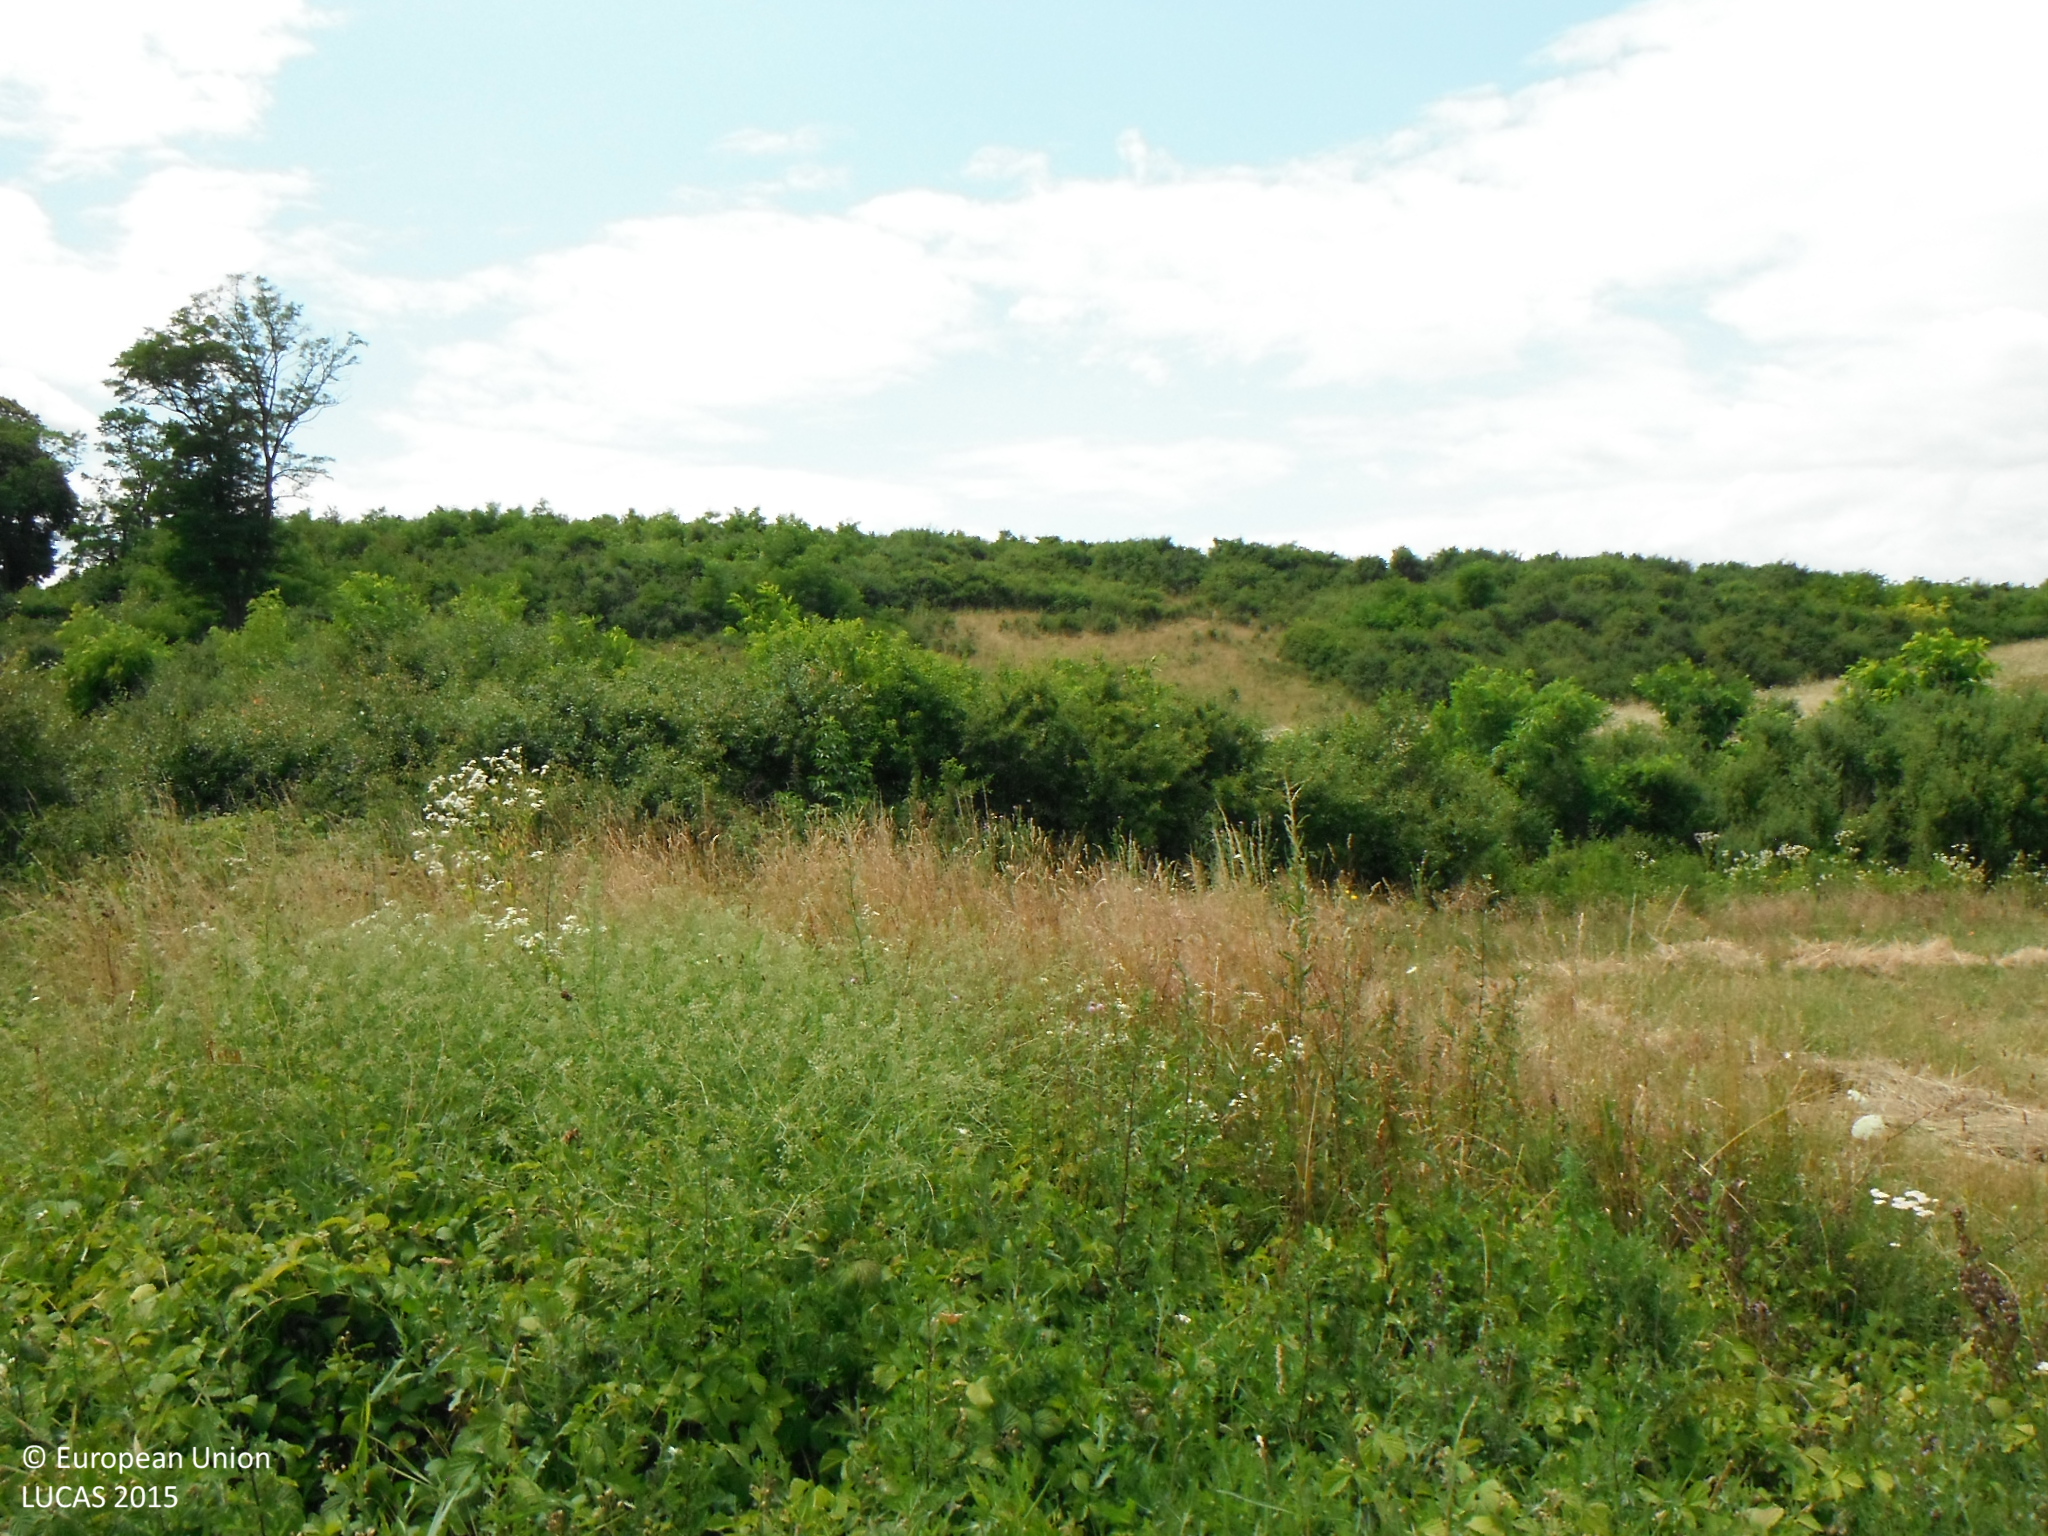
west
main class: Grassland
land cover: Spontaneously vegetated surfaces
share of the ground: > 75 %
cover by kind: herbaceous plants 100 %
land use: Semi-natural and natural areas not in use
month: July
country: SK
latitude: 48.3484
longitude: 20.1917
